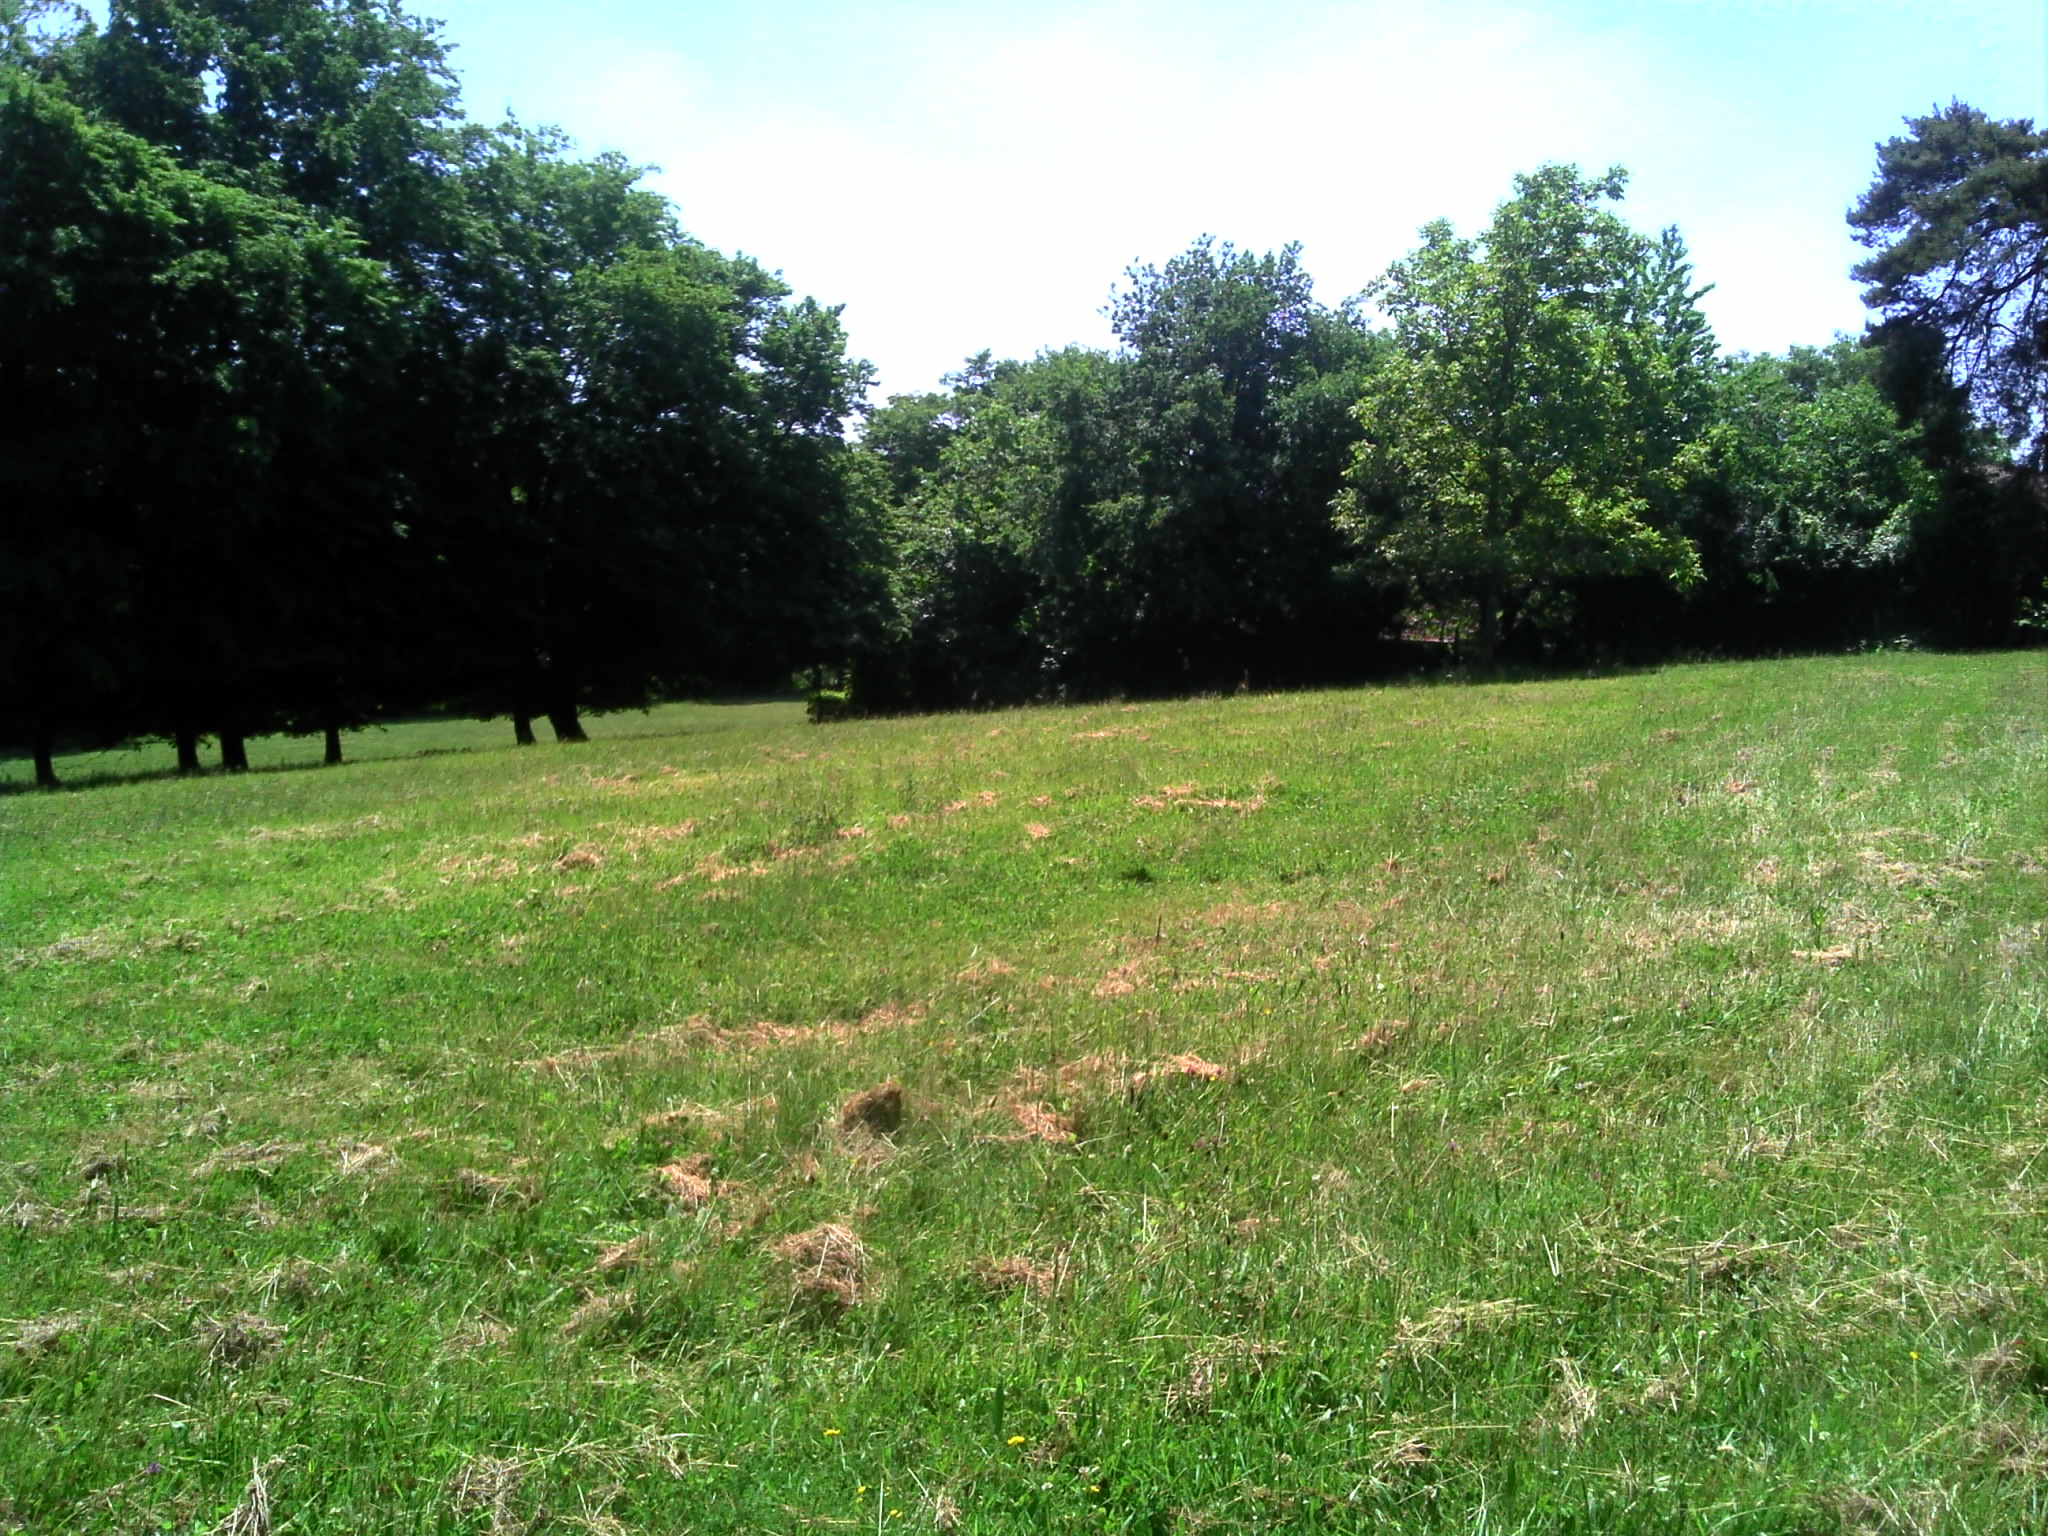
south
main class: Grassland
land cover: Grassland without tree/shrub cover
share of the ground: > 75 %
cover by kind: herbaceous plants 100 %
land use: Agriculture (excluding fallow land and kitchen gardens)
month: May
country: FR
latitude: 46.5282
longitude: 5.1133
